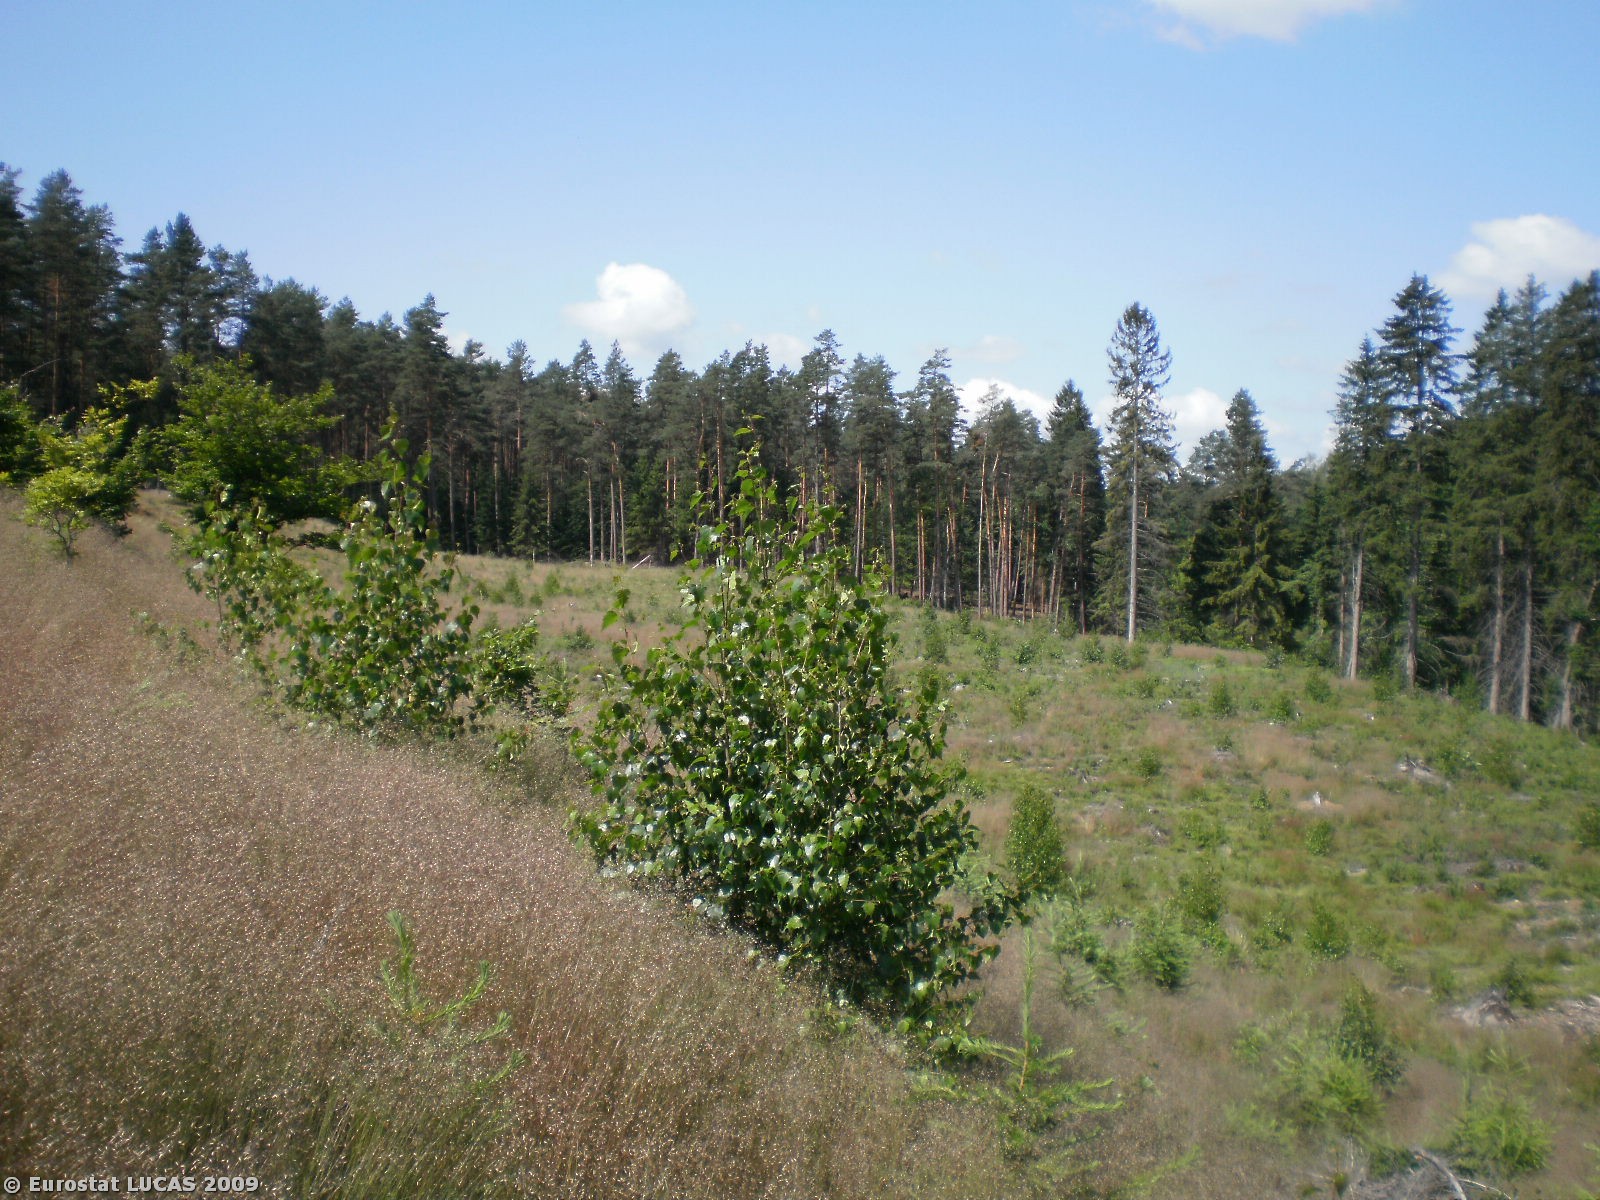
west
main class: Grassland
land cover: Grassland with sparse tree/shrub cover
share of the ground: > 75 %
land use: Forestry
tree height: > 5 m
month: July
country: PL
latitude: 54.2306
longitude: 17.2657
